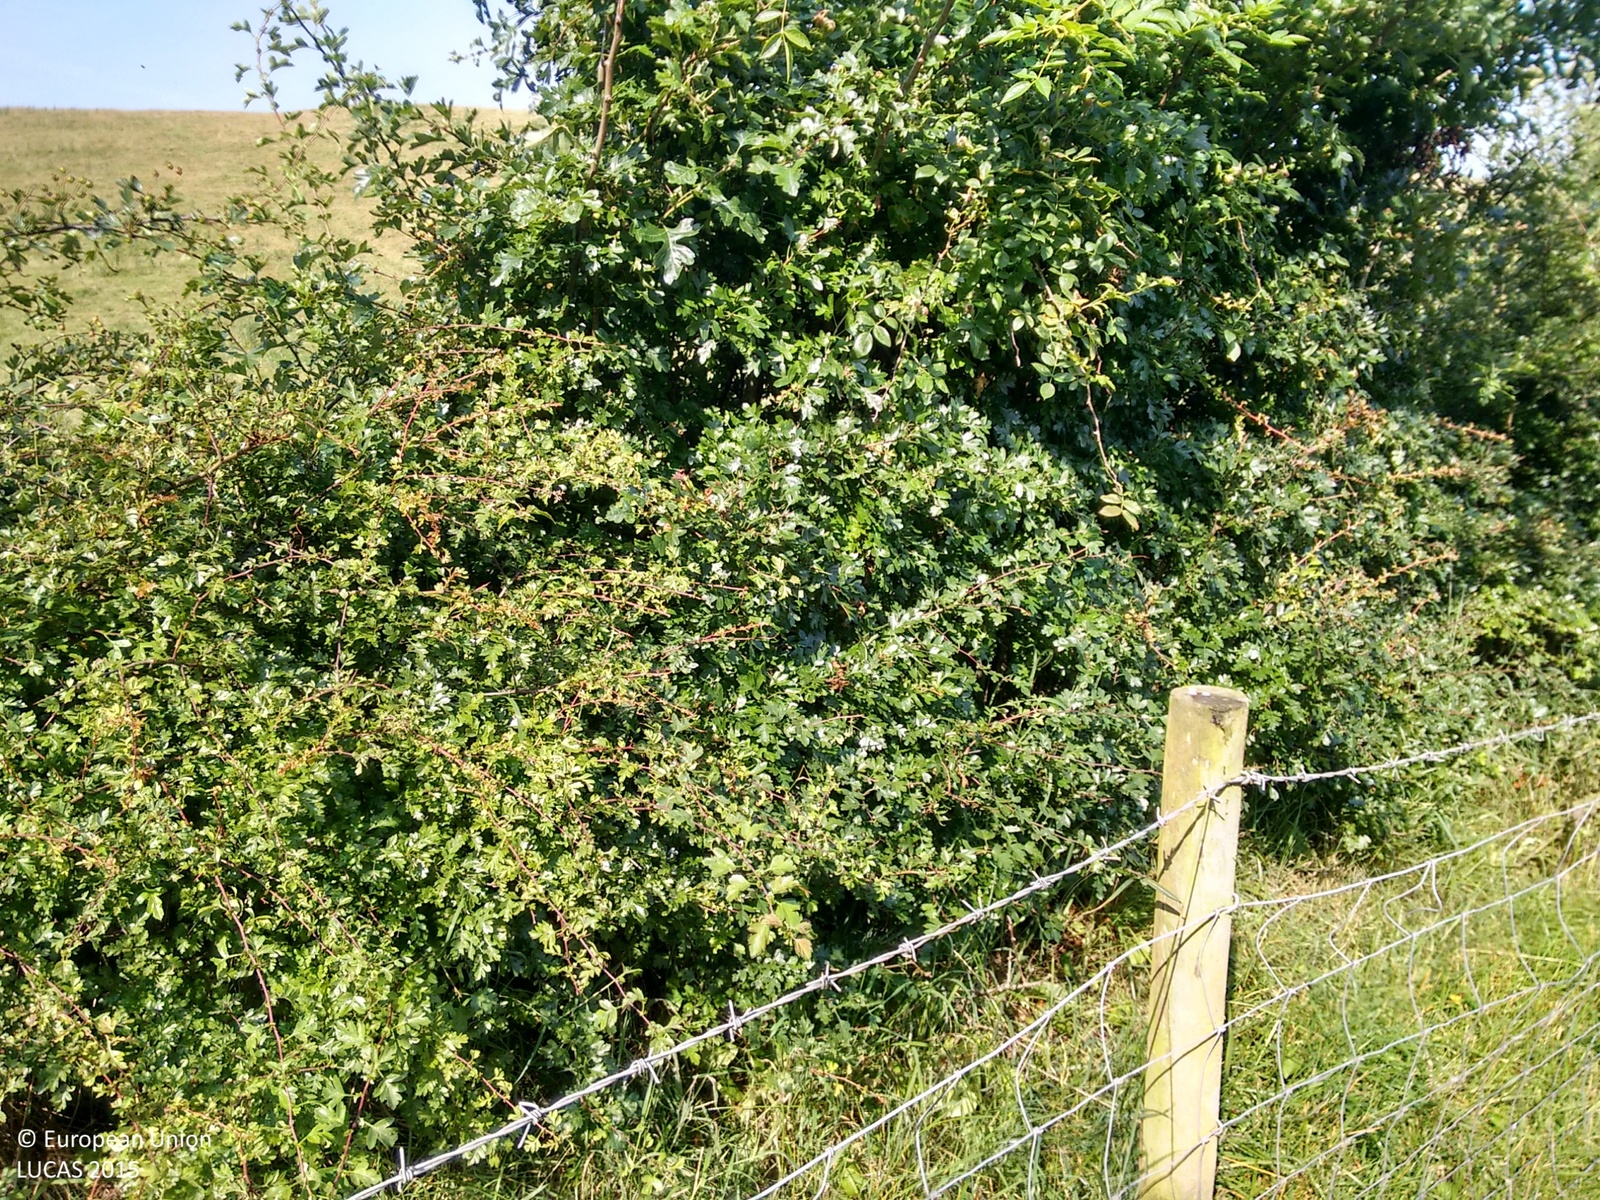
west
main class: Grassland
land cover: Grassland without tree/shrub cover
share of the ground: > 75 %
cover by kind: herbaceous plants 100 %
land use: Agriculture (excluding fallow land and kitchen gardens)
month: August
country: GB
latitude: 54.8063
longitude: -3.2224
